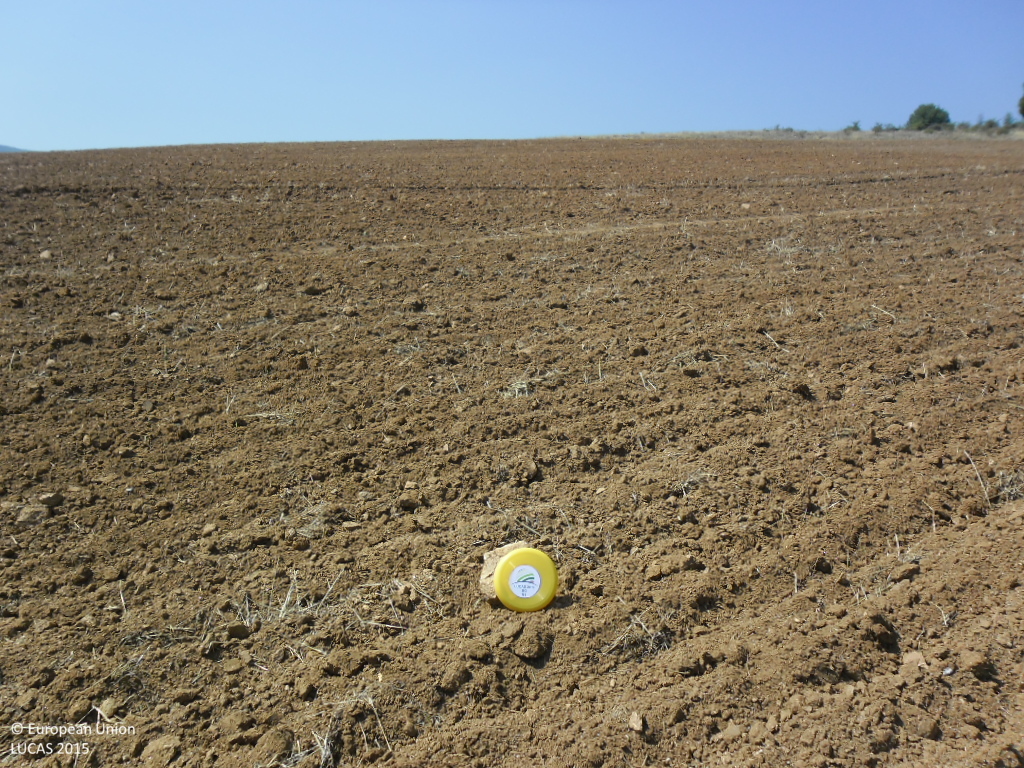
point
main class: Cropland
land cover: Common wheat
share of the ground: < 10 %
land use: Agriculture (excluding fallow land and kitchen gardens)
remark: Harvested field
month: August
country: BG
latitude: 42.0012
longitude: 22.9524
